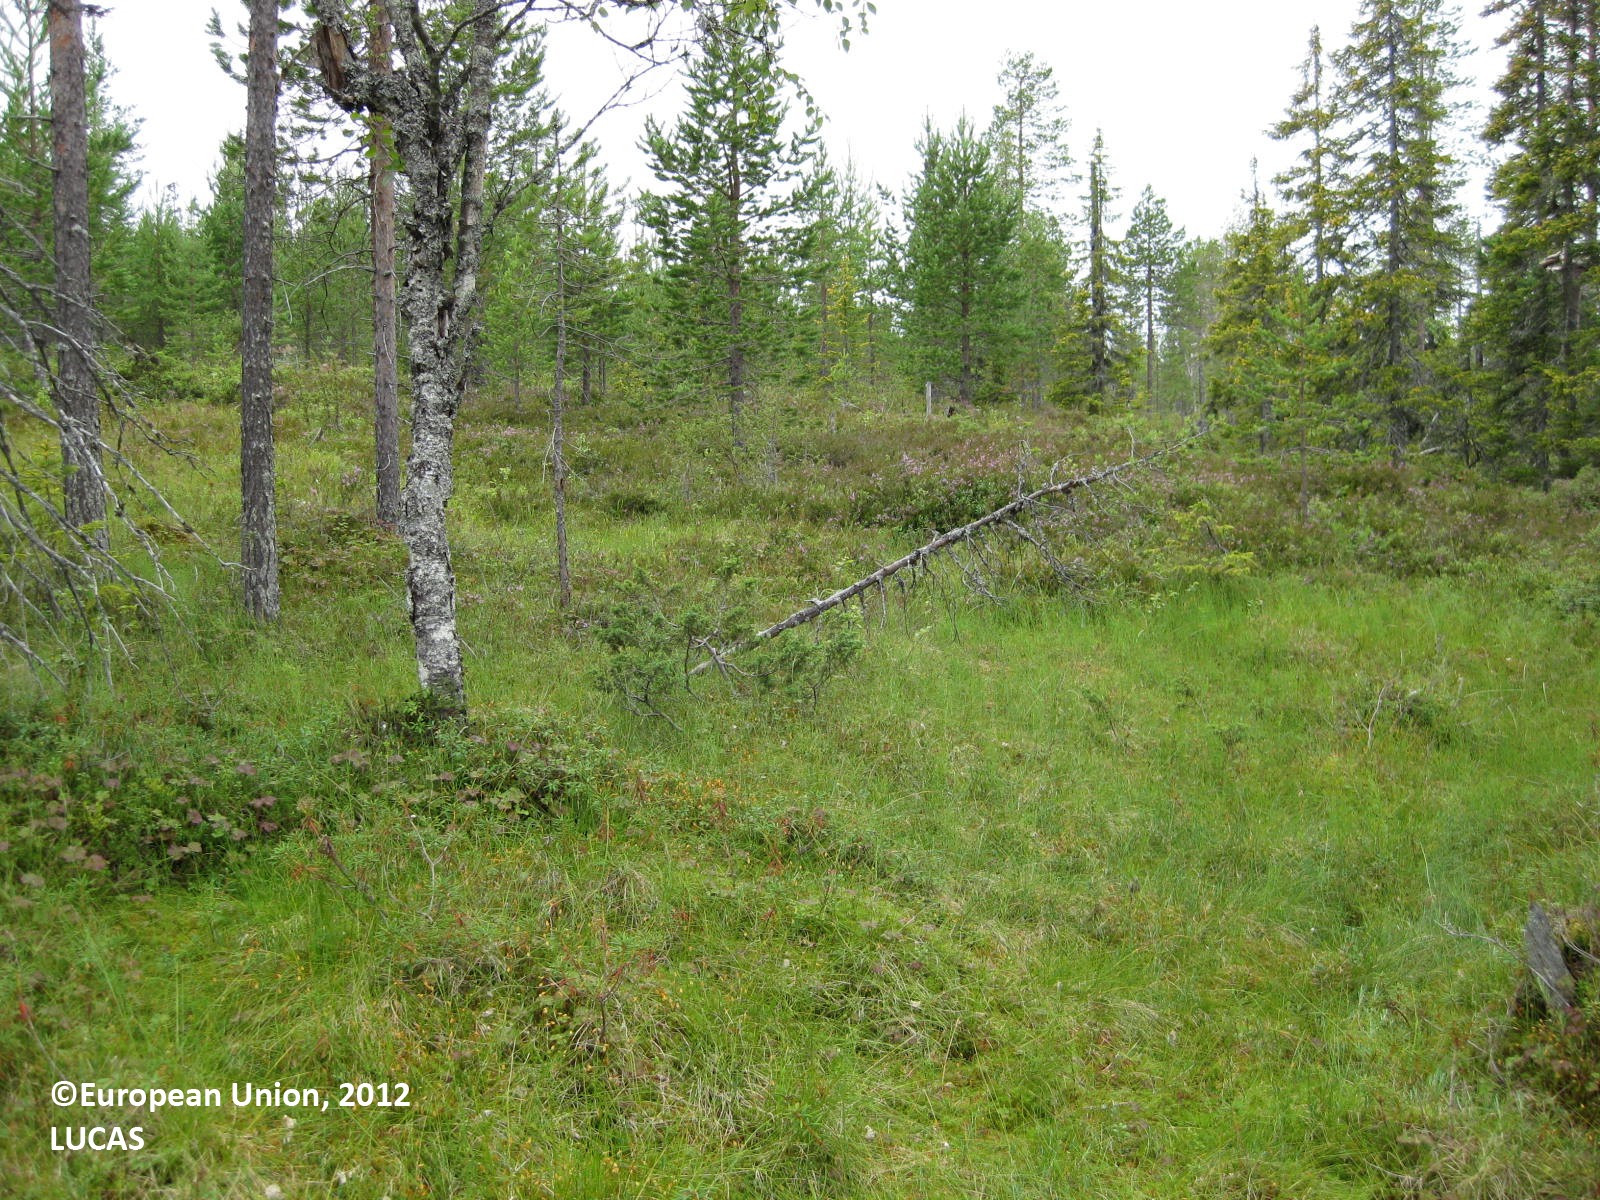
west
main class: Woodland
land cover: Pine dominated coniferous woodland
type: boreal forest
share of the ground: 10 - 25 %
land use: Semi-natural and natural areas not in use
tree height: > 5 m
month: August
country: FI
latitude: 66.0152
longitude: 28.2452
